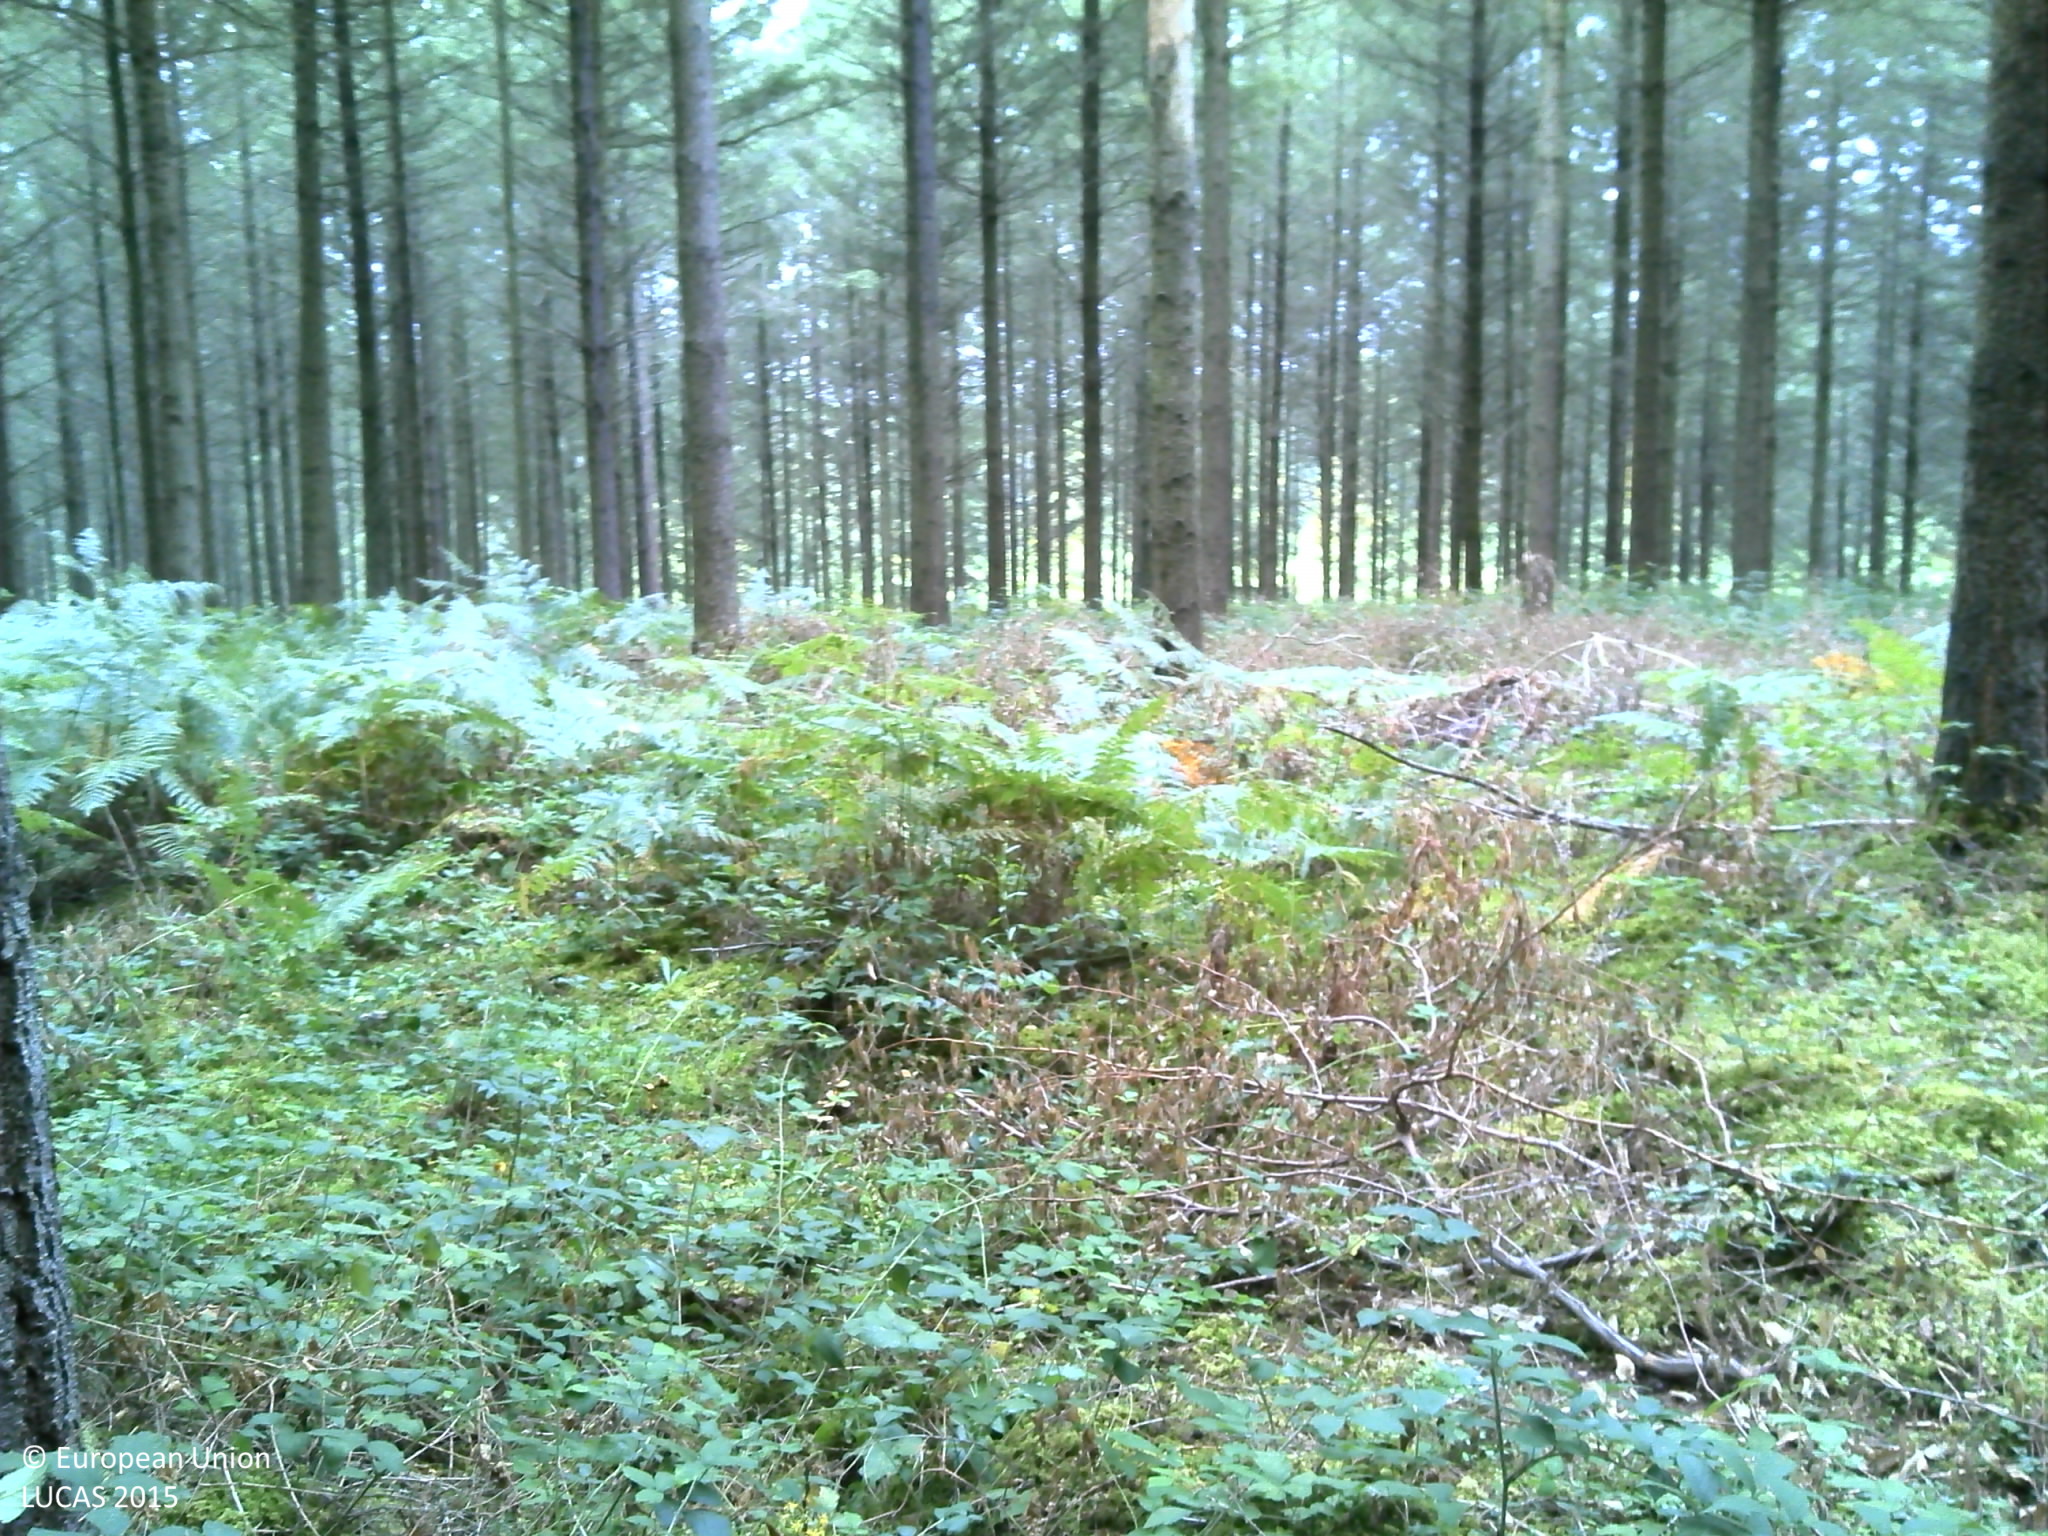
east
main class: Woodland
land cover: Other coniferous woodland
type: exotic forest
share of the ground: > 75 %
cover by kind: coniferous forest trees 85 %, herbaceous plants 15 %
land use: Forestry
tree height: > 5 m
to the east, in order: Other coniferous woodland; Rock outcrops; Ditches and canals; Fences; Grassland without tree/shrub cover; Rivers and streams; Grassland without tree/shrub cover; Managed hedges; Fences; Grassland without tree/shrub cover
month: October
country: FR
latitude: 46.6359
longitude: 4.0303
